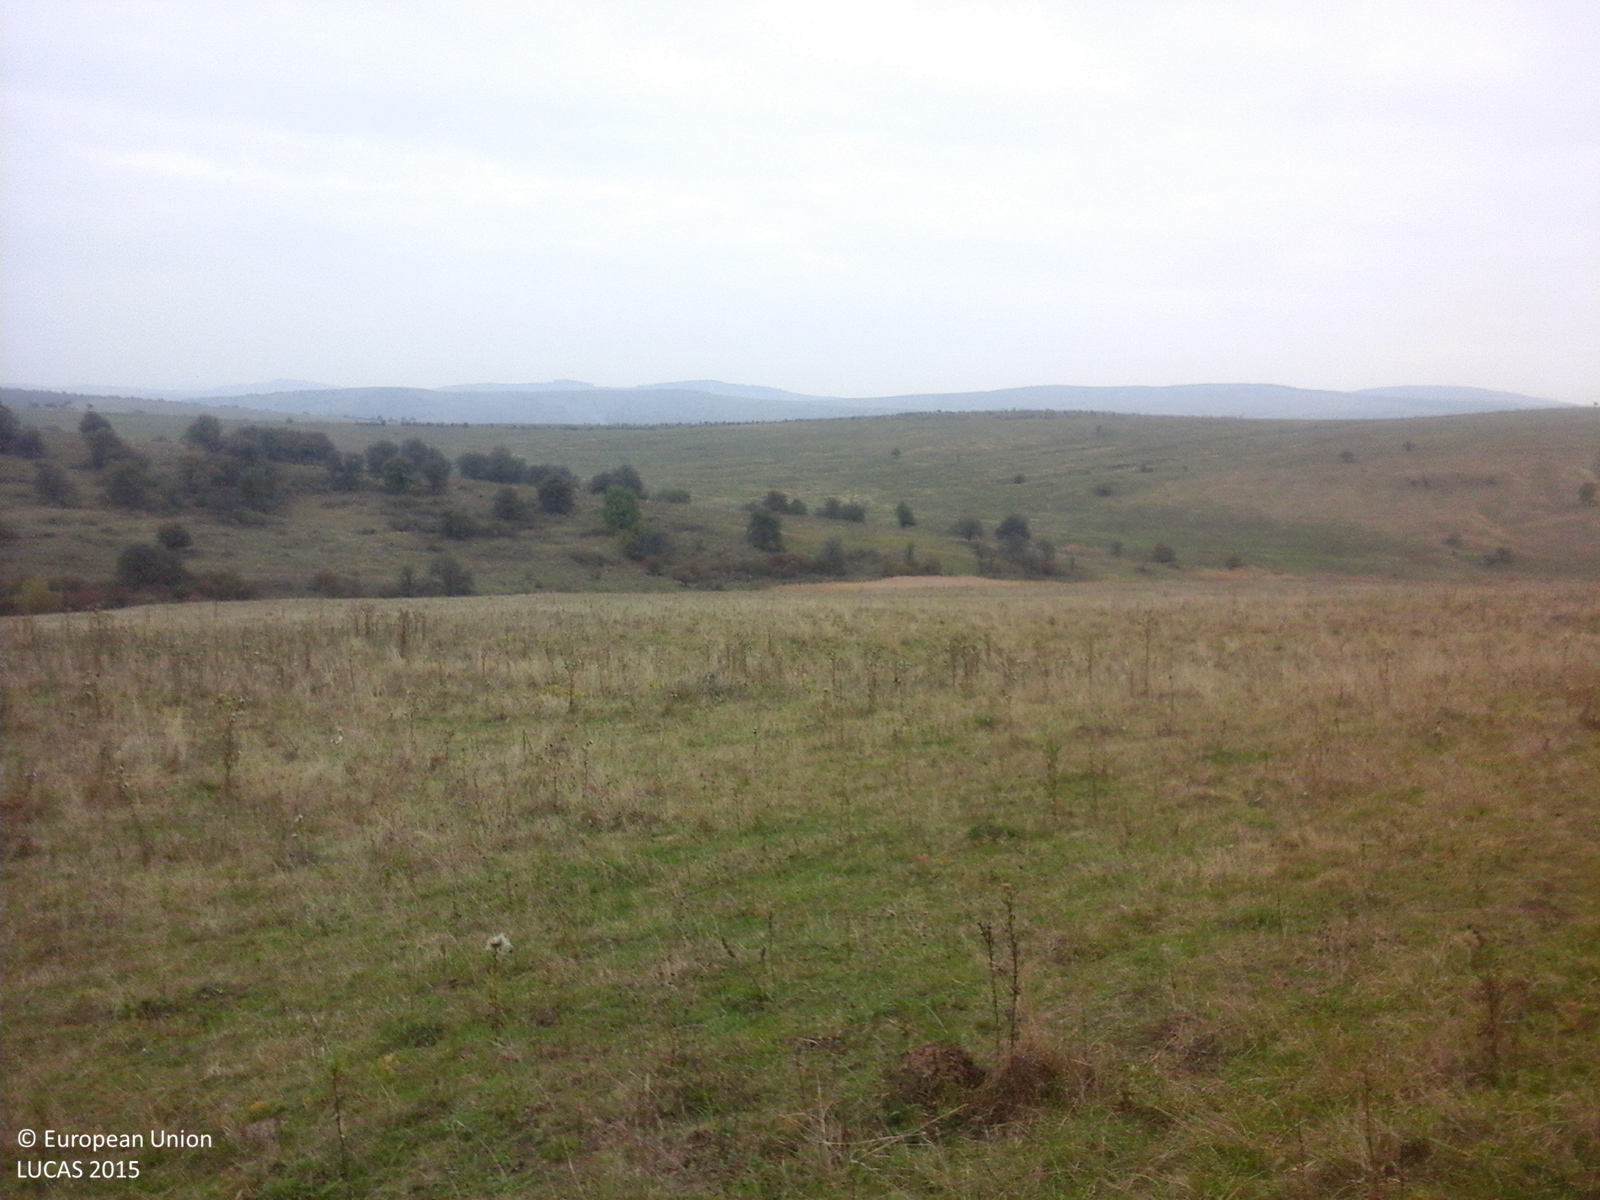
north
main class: Grassland
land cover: Grassland without tree/shrub cover
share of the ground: > 75 %
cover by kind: herbaceous plants 100 %
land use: Agriculture (excluding fallow land and kitchen gardens)
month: October
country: RO
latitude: 46.0965
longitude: 25.2203
